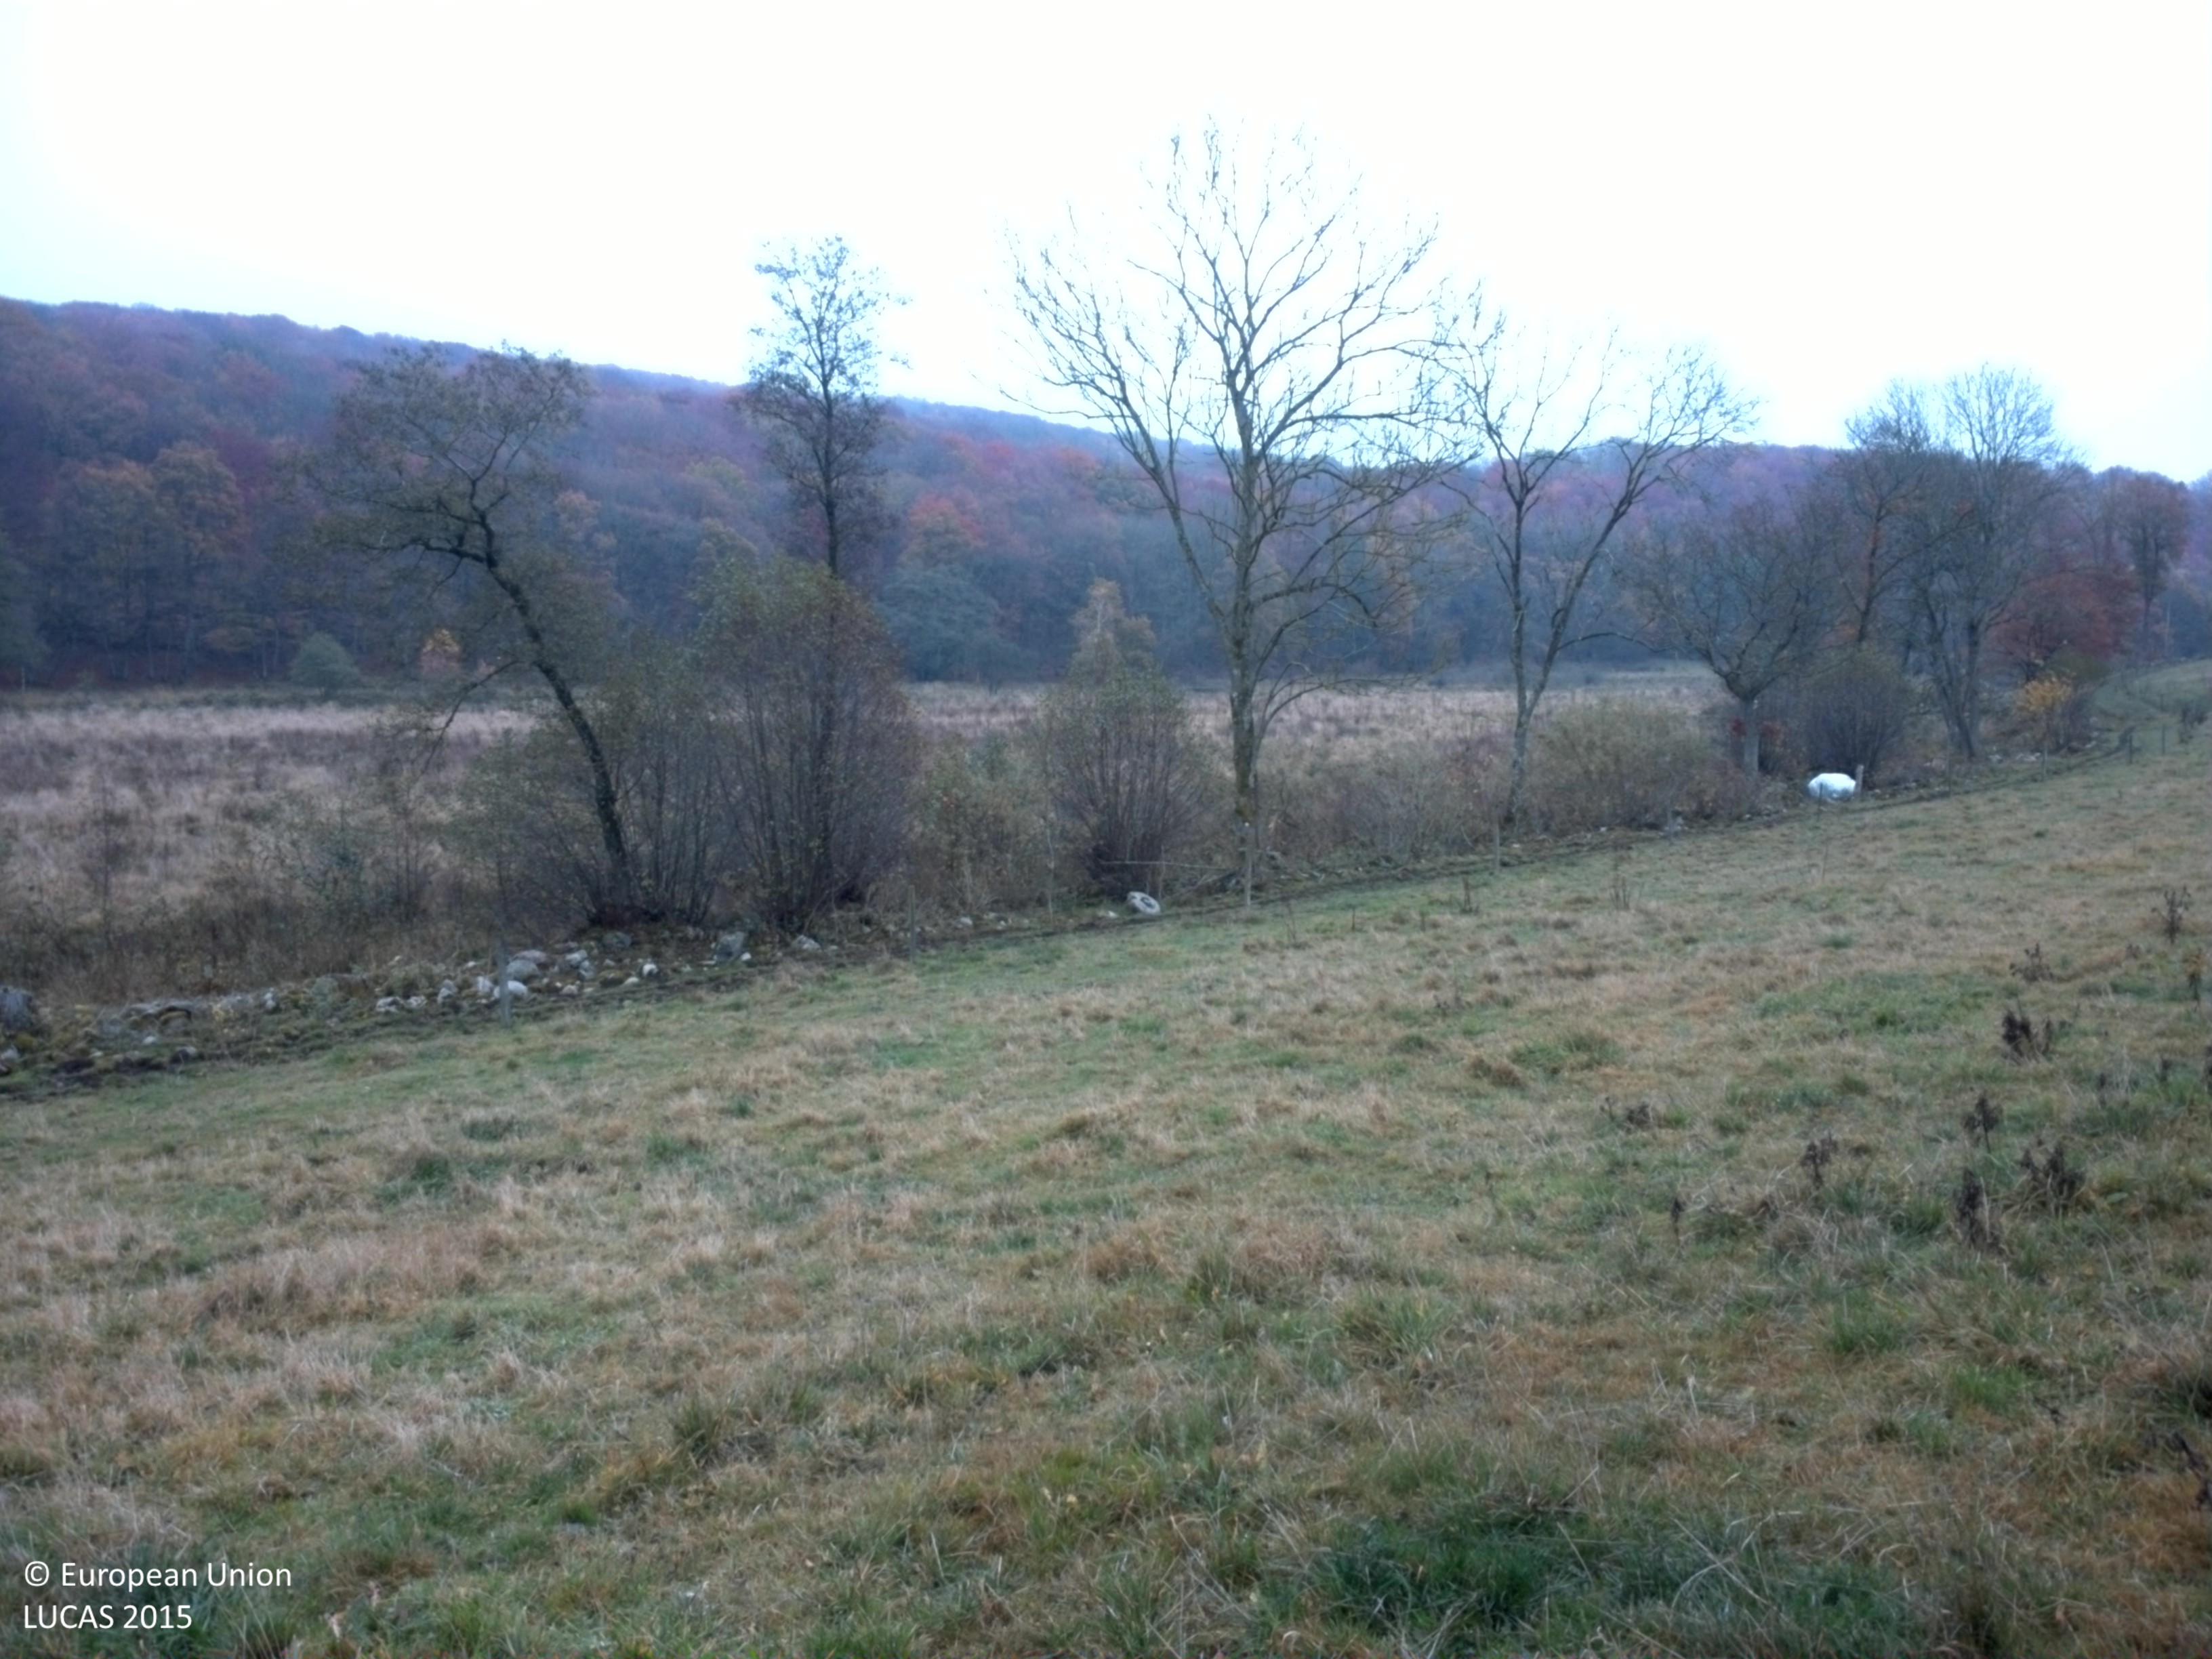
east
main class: Grassland
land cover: Grassland without tree/shrub cover
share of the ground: > 75 %
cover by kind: herbaceous plants 100 %
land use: Agriculture (excluding fallow land and kitchen gardens)
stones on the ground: < 10 %
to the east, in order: Grassland without tree/shrub cover; Fences; Abandoned hedges; Dry stone walls; Abandoned hedges; Grassland without tree/shrub cover; Fences; Ditches and canals; Fences; Grassland without tree/shrub cover; Dry stone walls; Broadleaved woodland
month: November
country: SE
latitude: 56.0433
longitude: 13.0636
